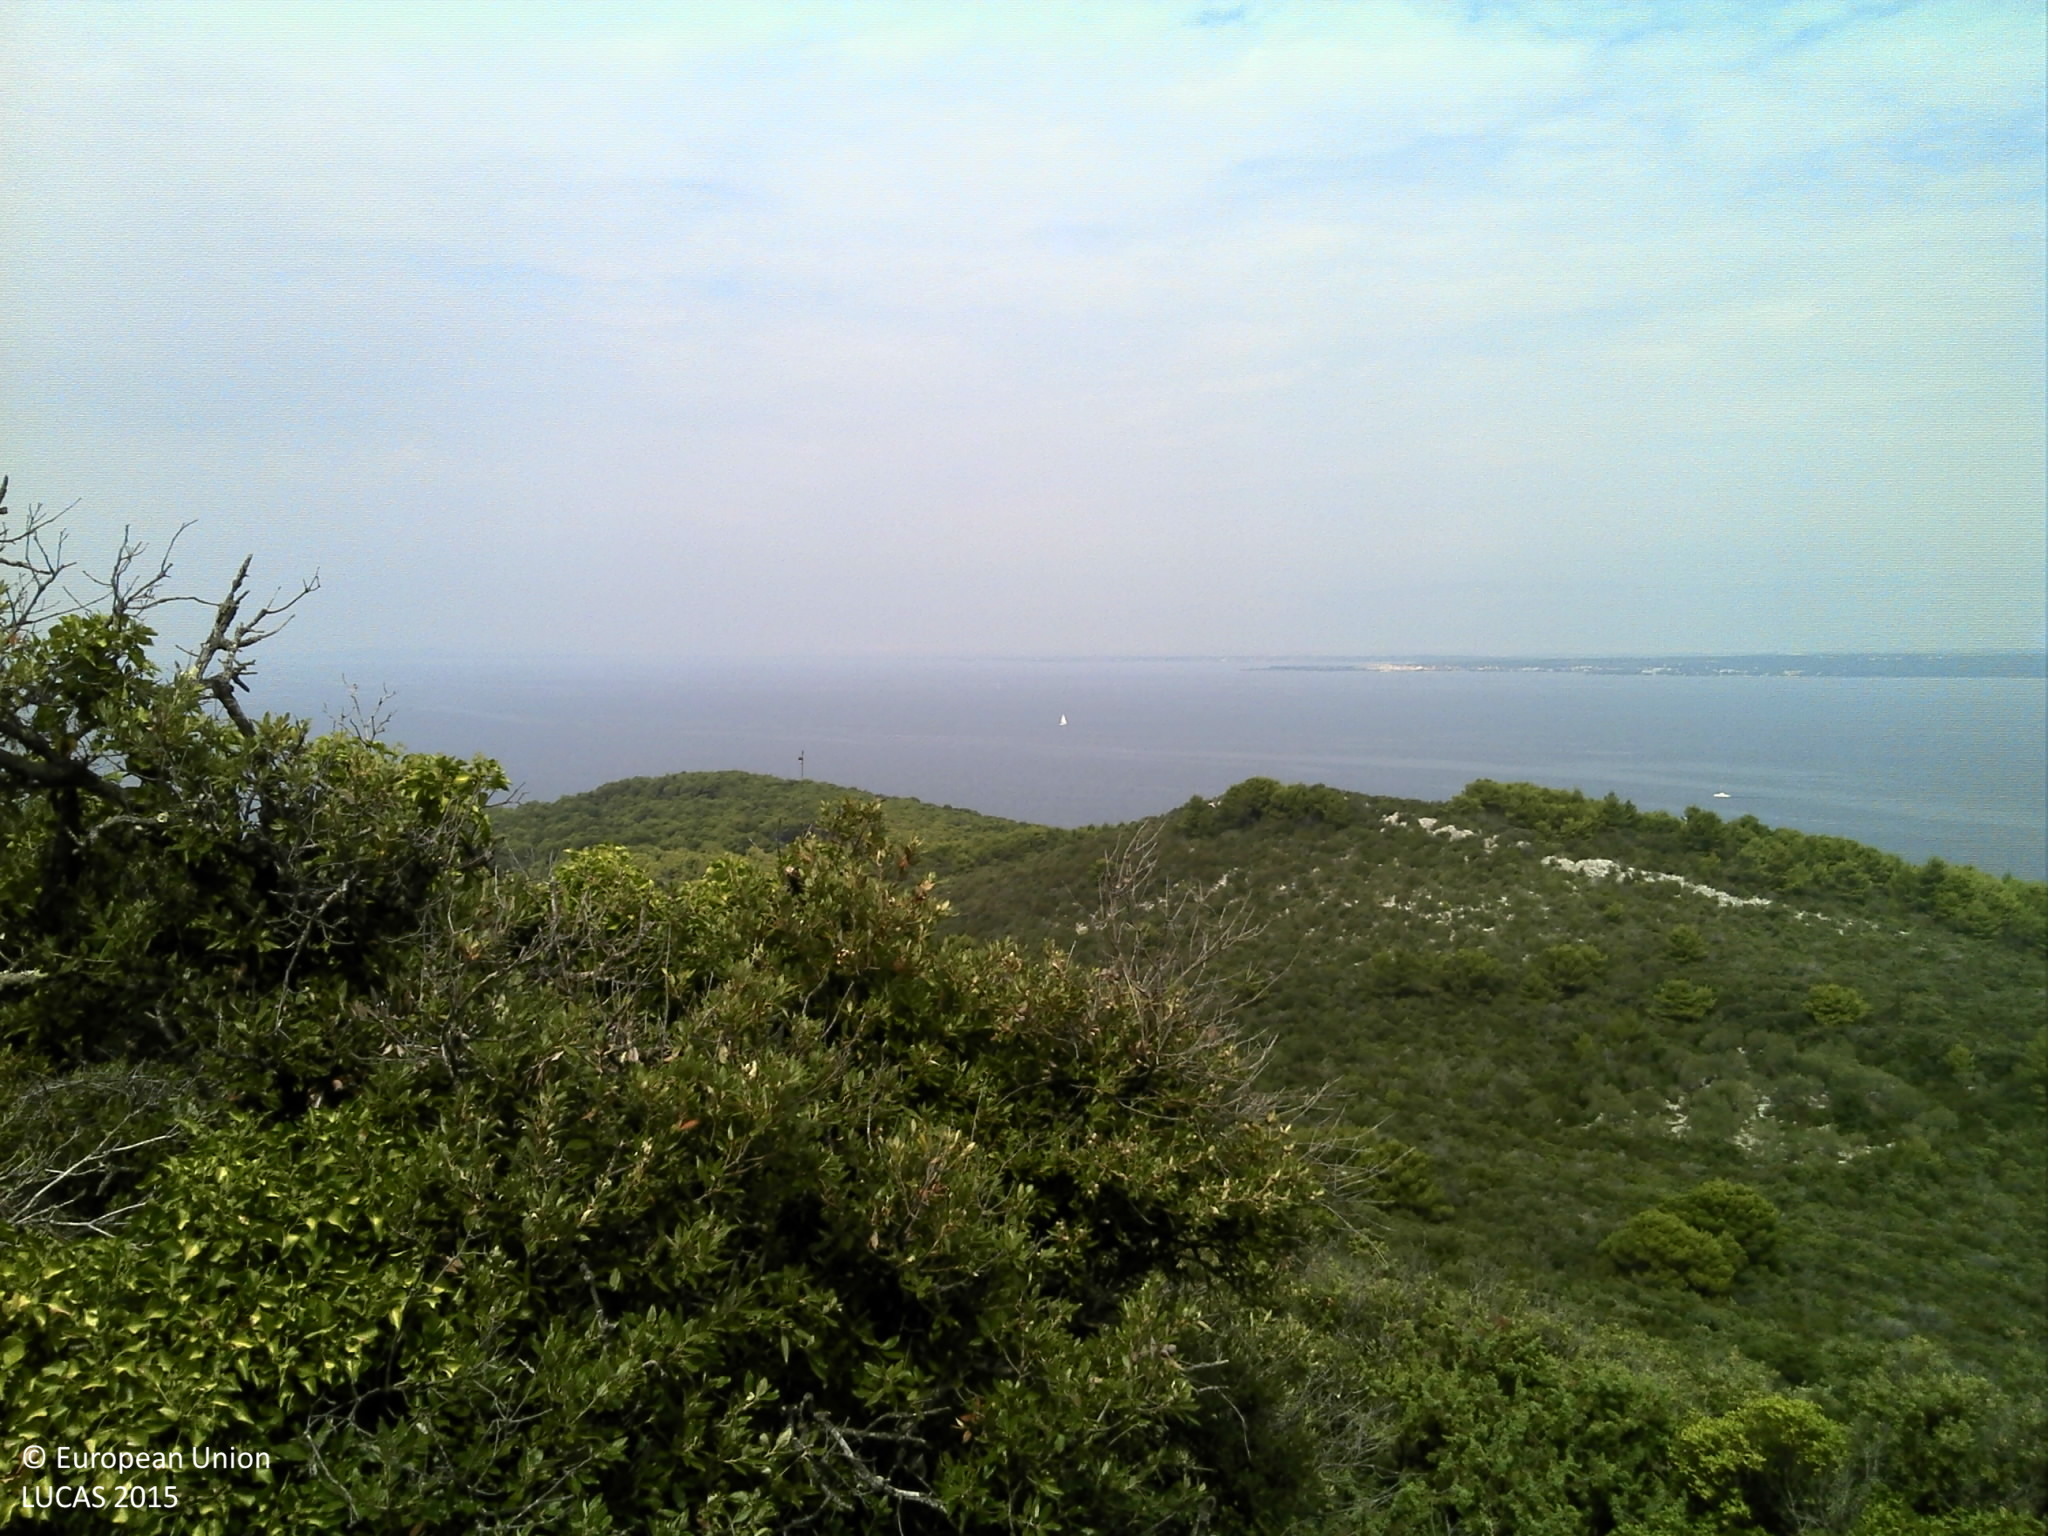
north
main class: Shrubland
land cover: Shrubland with sparse tree cover
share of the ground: > 75 %
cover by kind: shrubs 80 %, consolidated bare surface 10 %, broadleaved forest trees 5 %, herbaceous plants 5 %
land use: Semi-natural and natural areas not in use
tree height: < 5 m
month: September
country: HR
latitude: 44.1154
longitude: 15.1274
